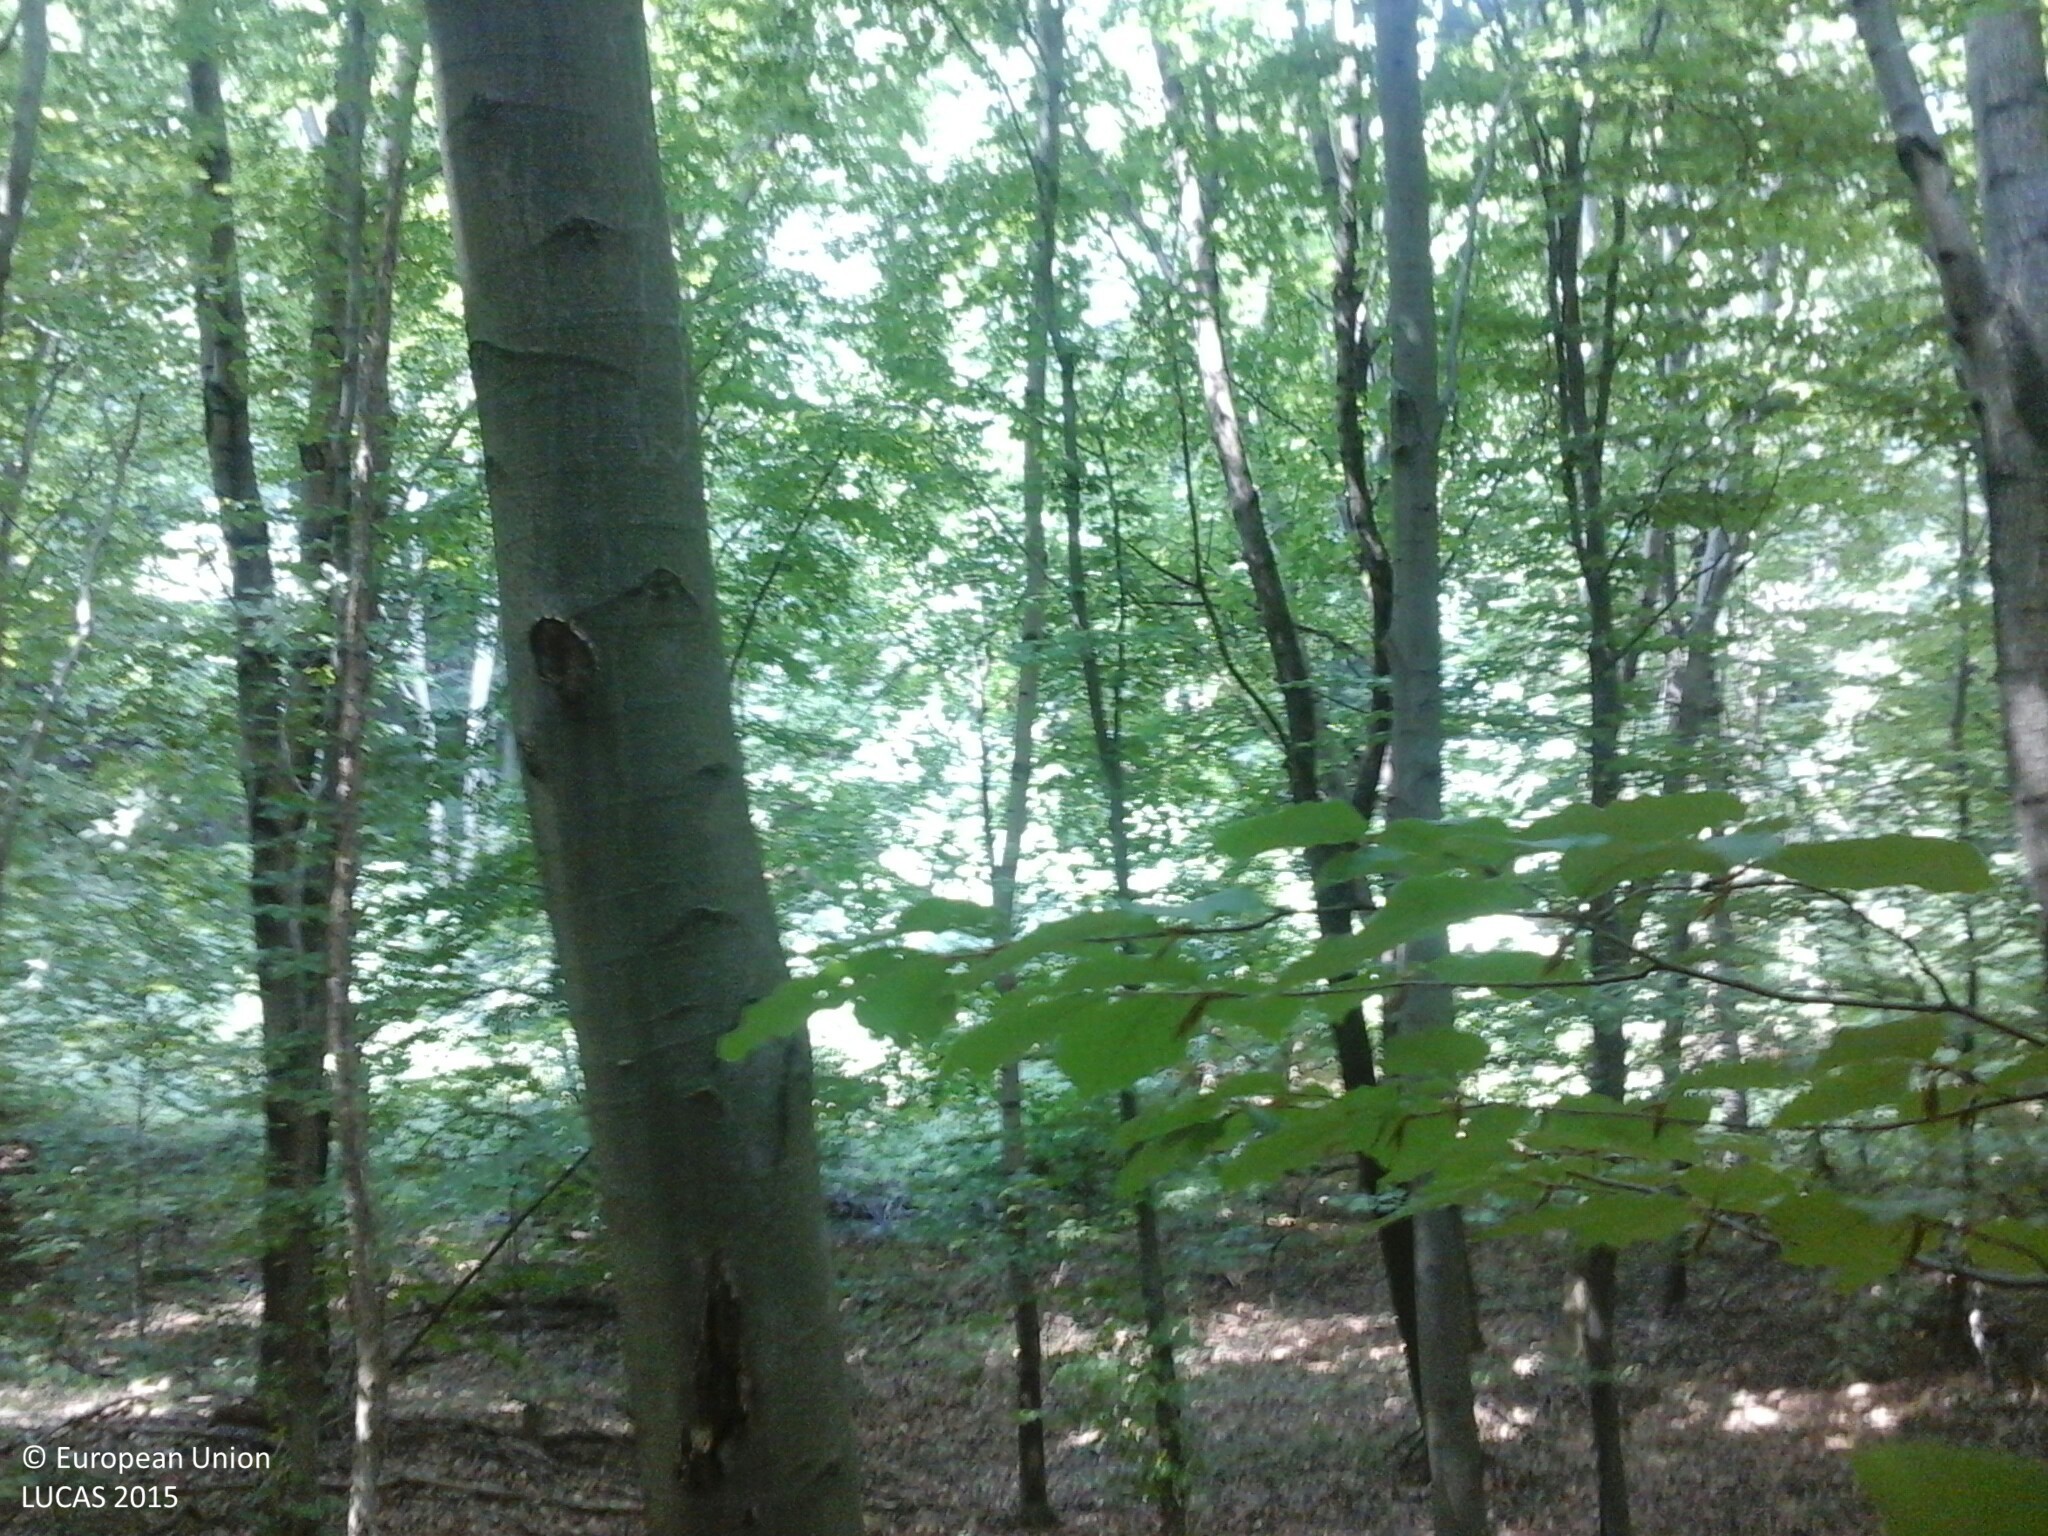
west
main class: Woodland
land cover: Broadleaved woodland
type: beech forest
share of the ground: > 75 %
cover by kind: broadleaved forest trees 100 %
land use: Forestry
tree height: > 5 m
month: August
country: HU
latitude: 47.4041
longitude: 18.2942
